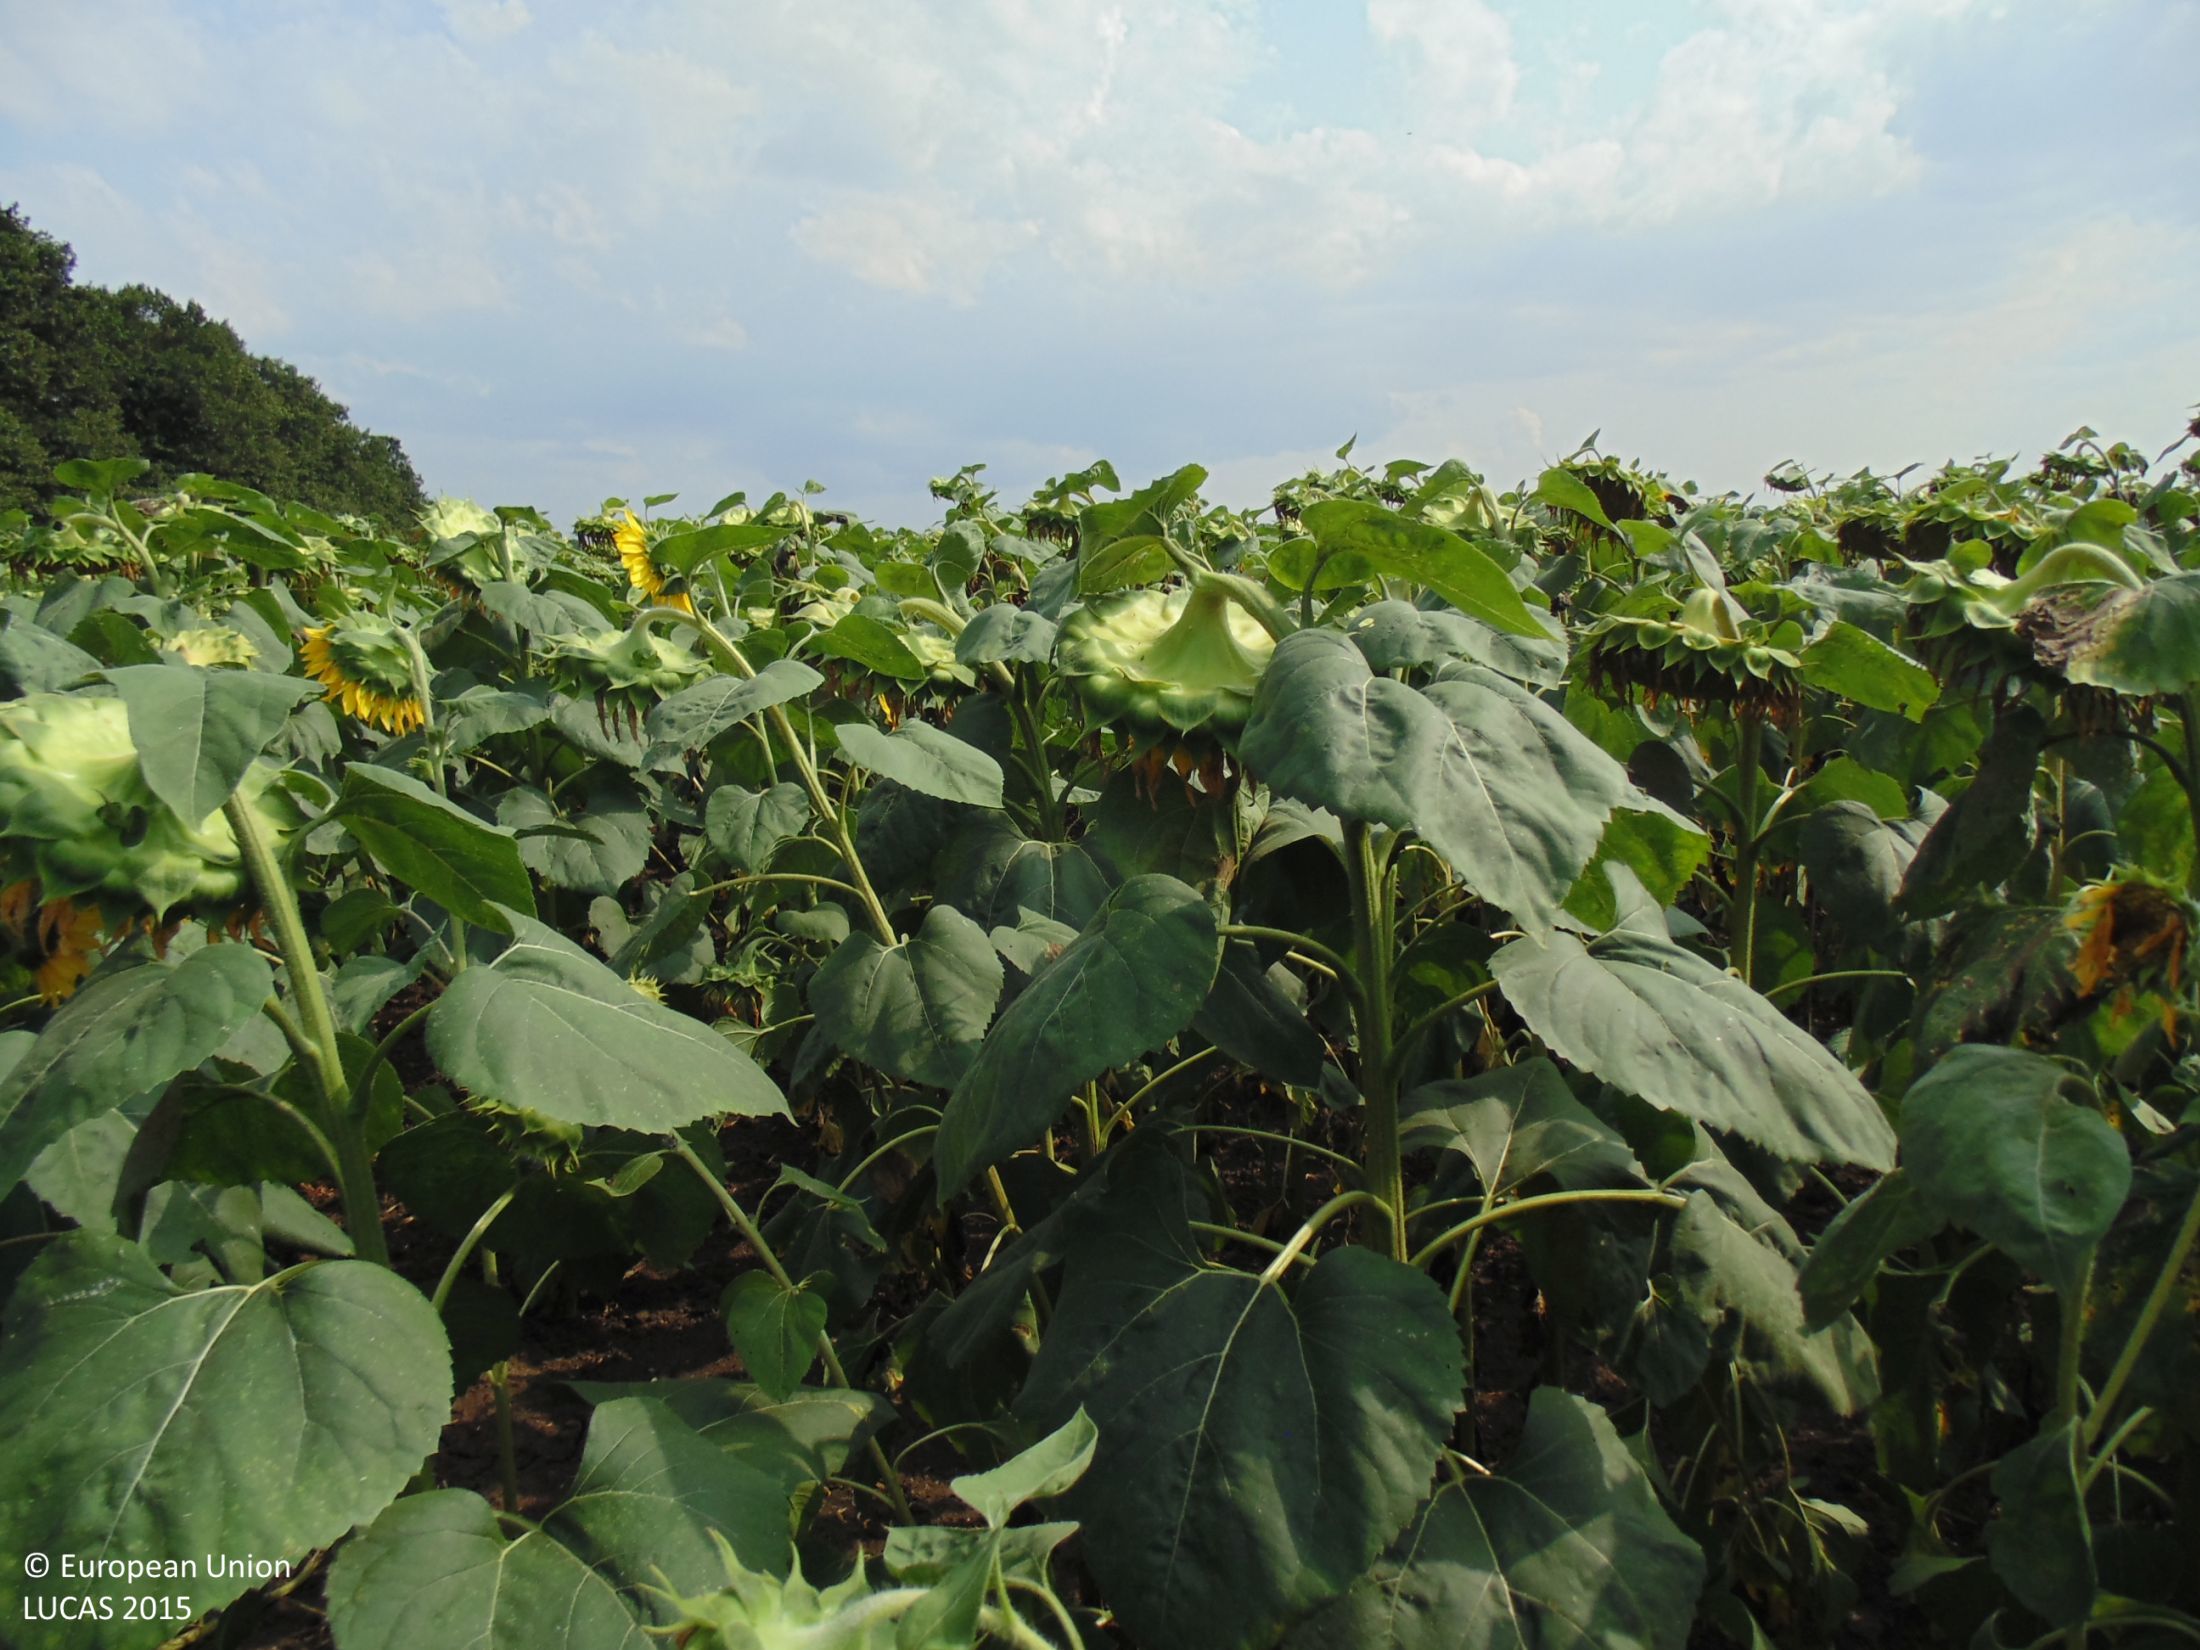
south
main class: Cropland
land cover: Sunflower
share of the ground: > 75 %
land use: Agriculture (excluding fallow land and kitchen gardens)
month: July
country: BG
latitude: 43.6046
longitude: 28.0248
